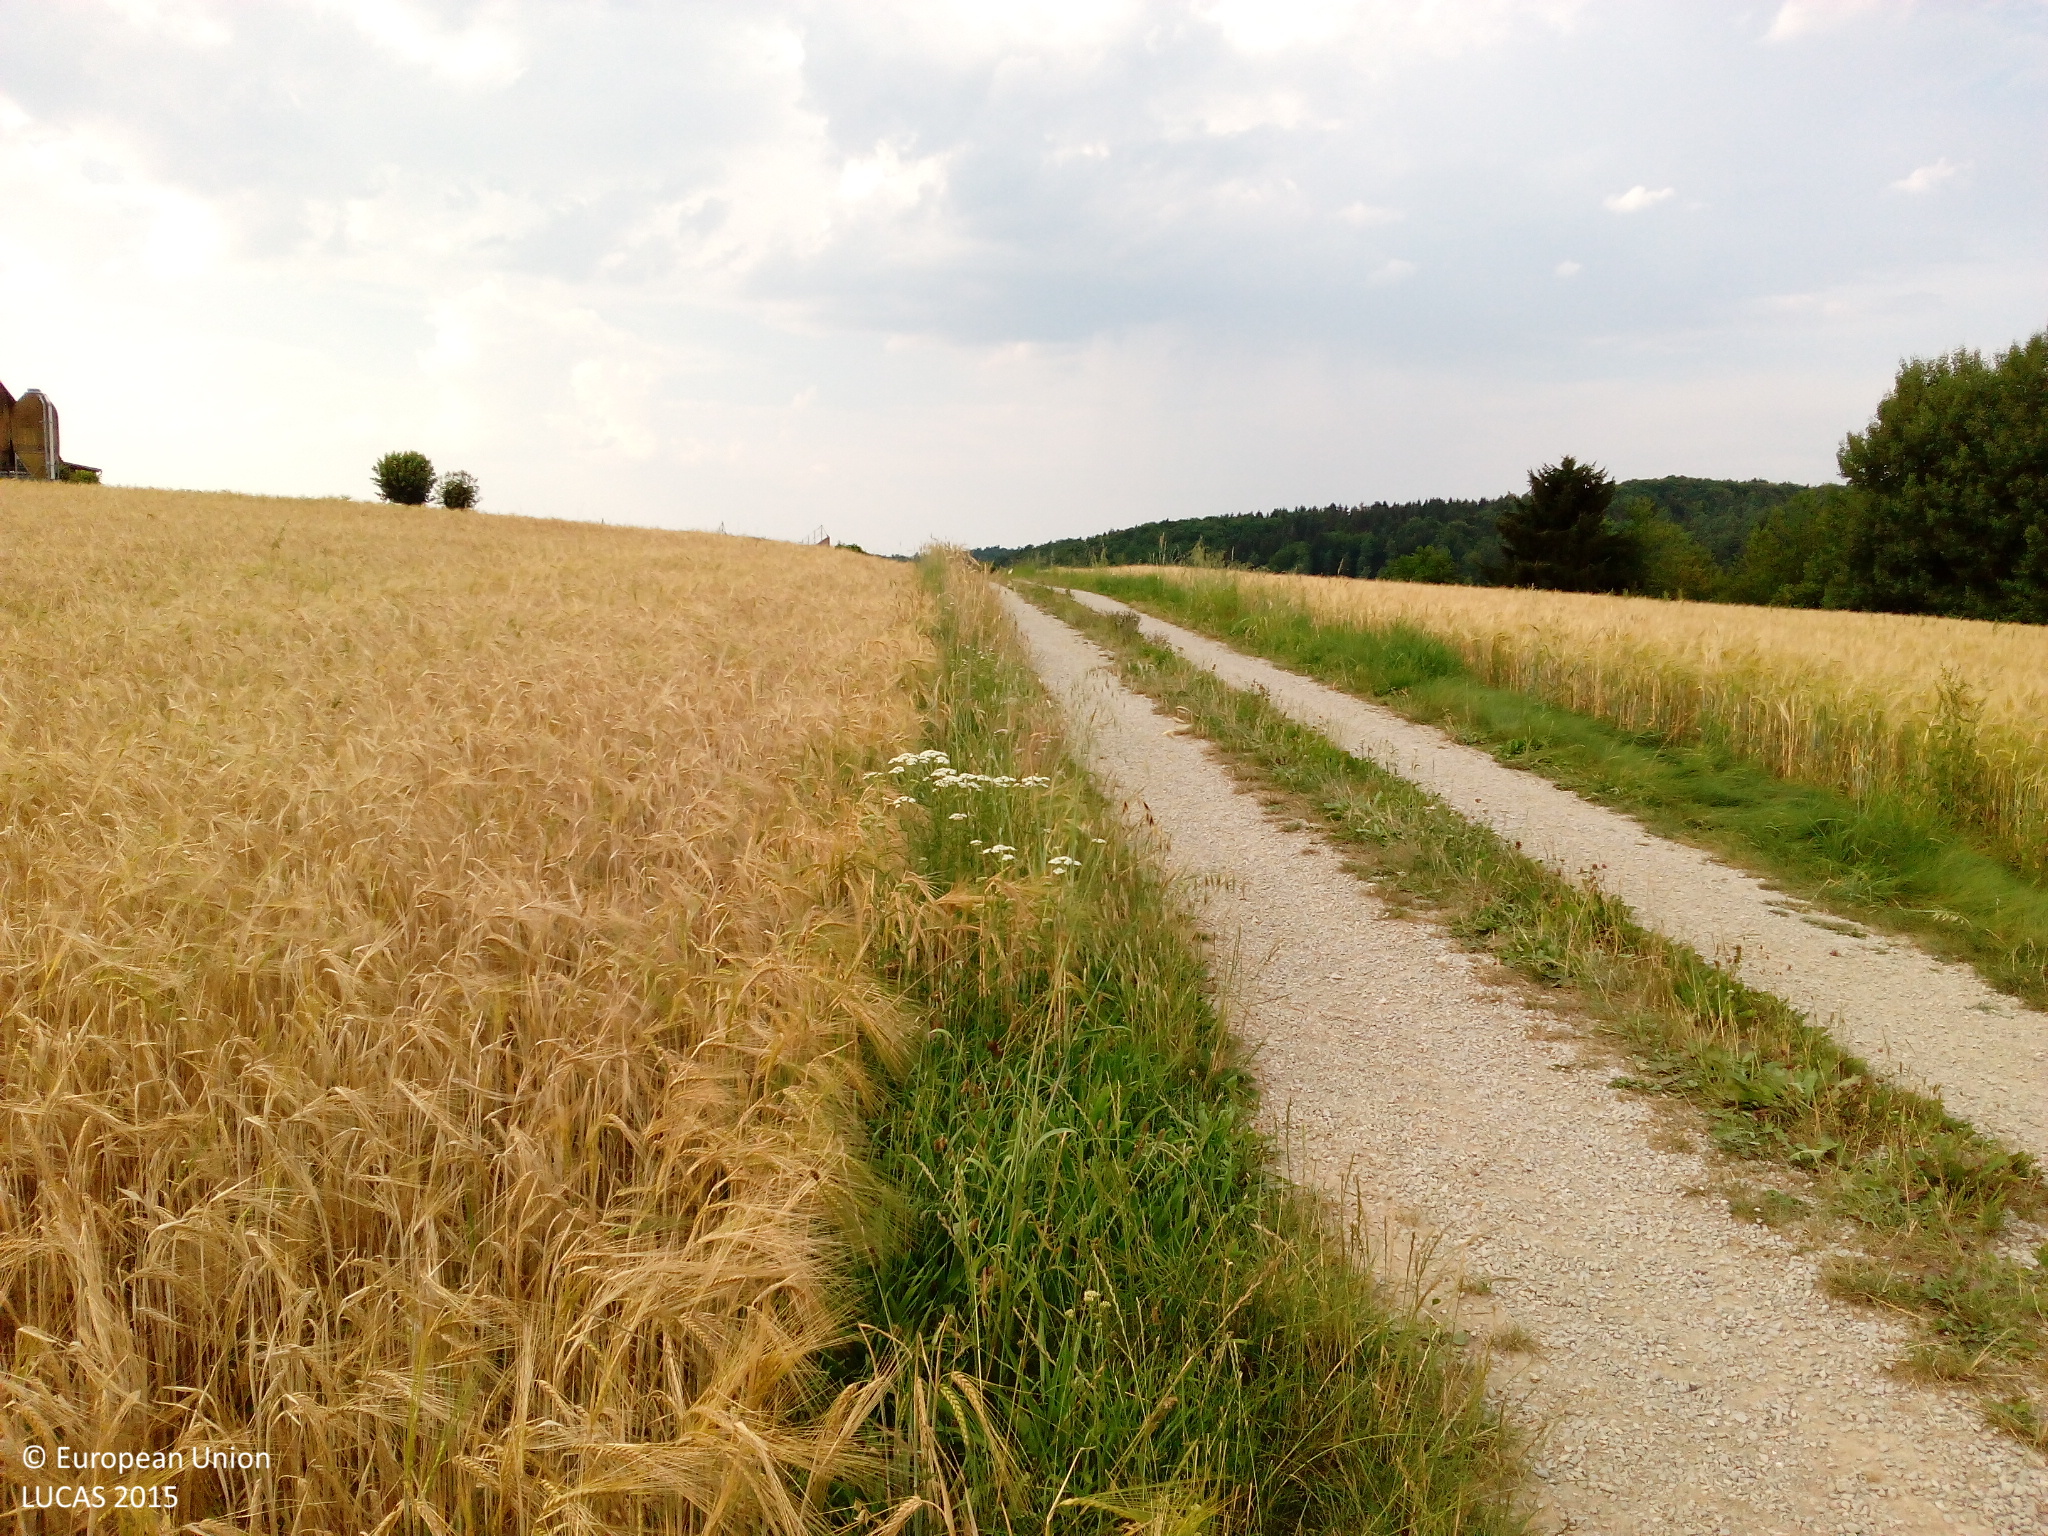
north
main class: Cropland
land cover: Barley
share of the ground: > 75 %
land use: Agriculture (excluding fallow land and kitchen gardens)
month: July
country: DE
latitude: 49.6350
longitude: 11.4811
